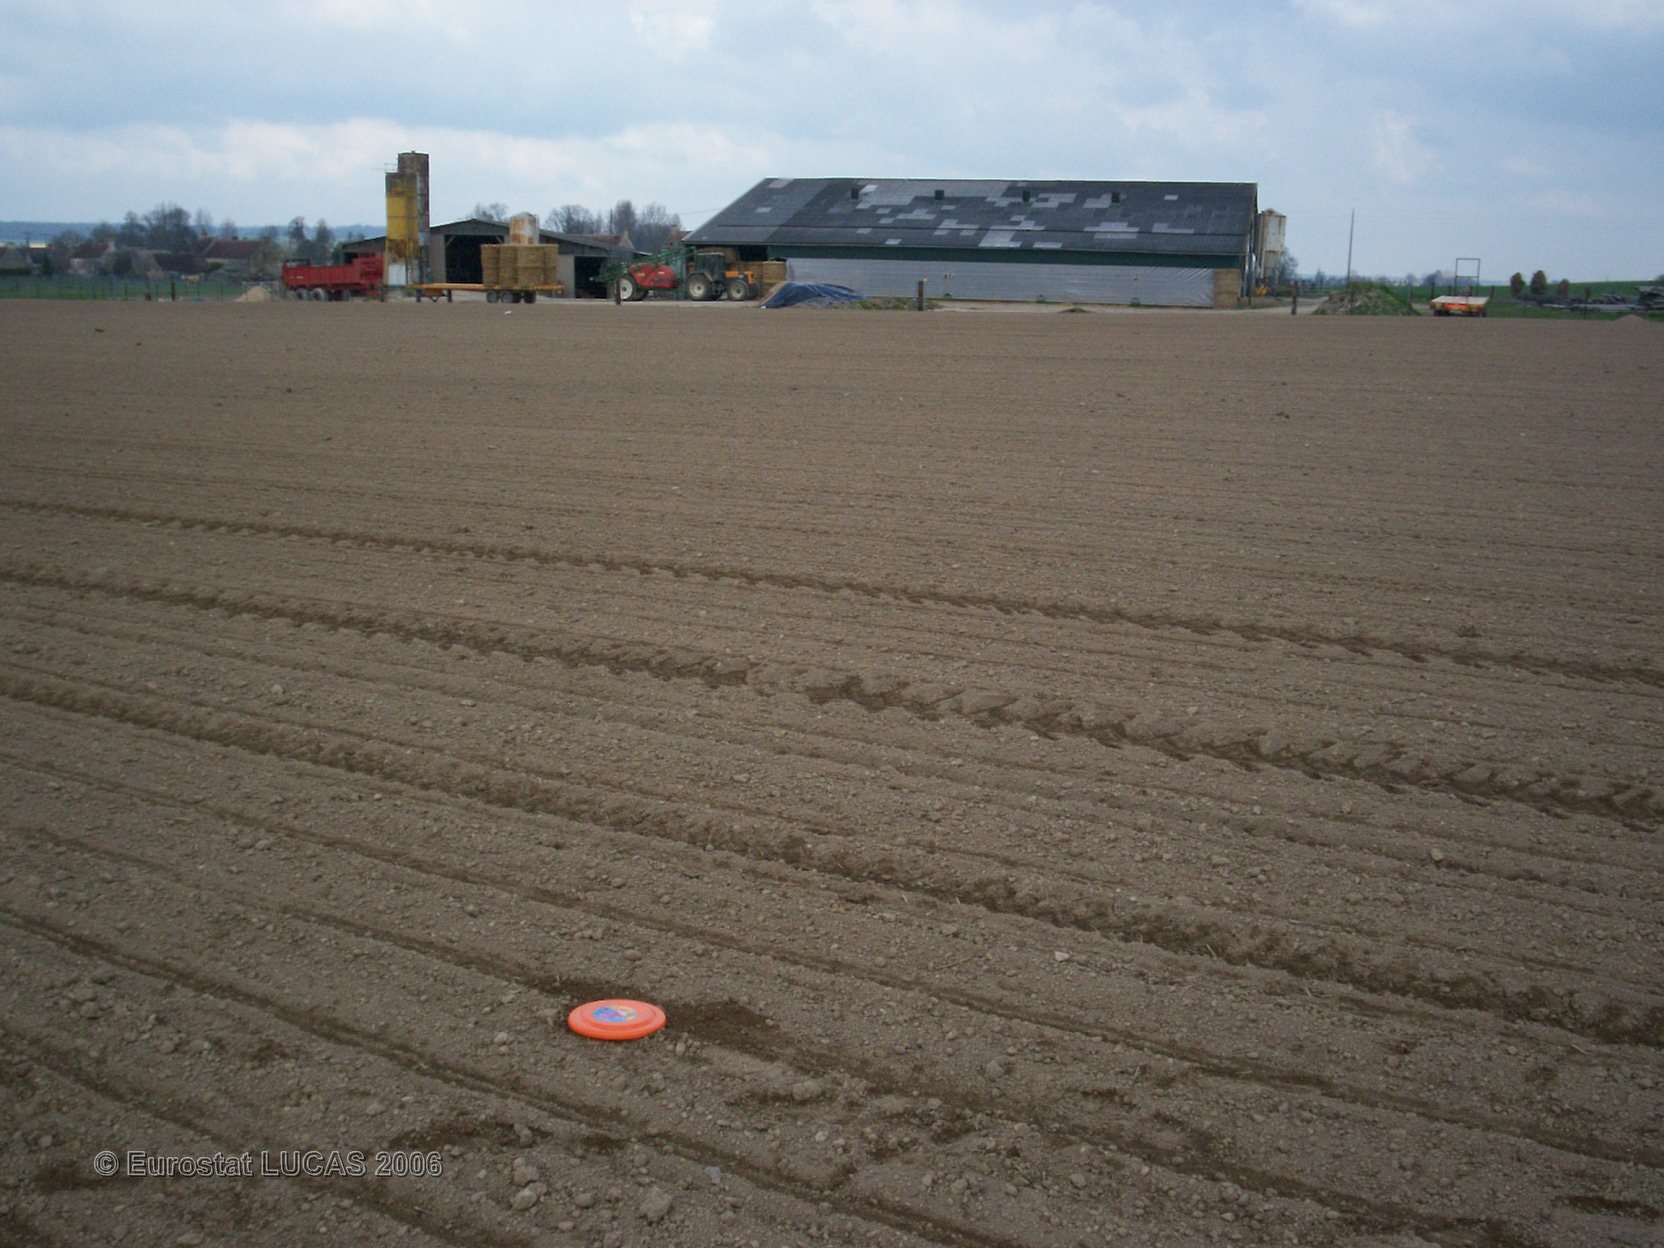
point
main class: Cropland
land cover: Sugar beet
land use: Agriculture (excluding fallow land and kitchen gardens)
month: May
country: FR
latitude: 48.9223
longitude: -0.0622
